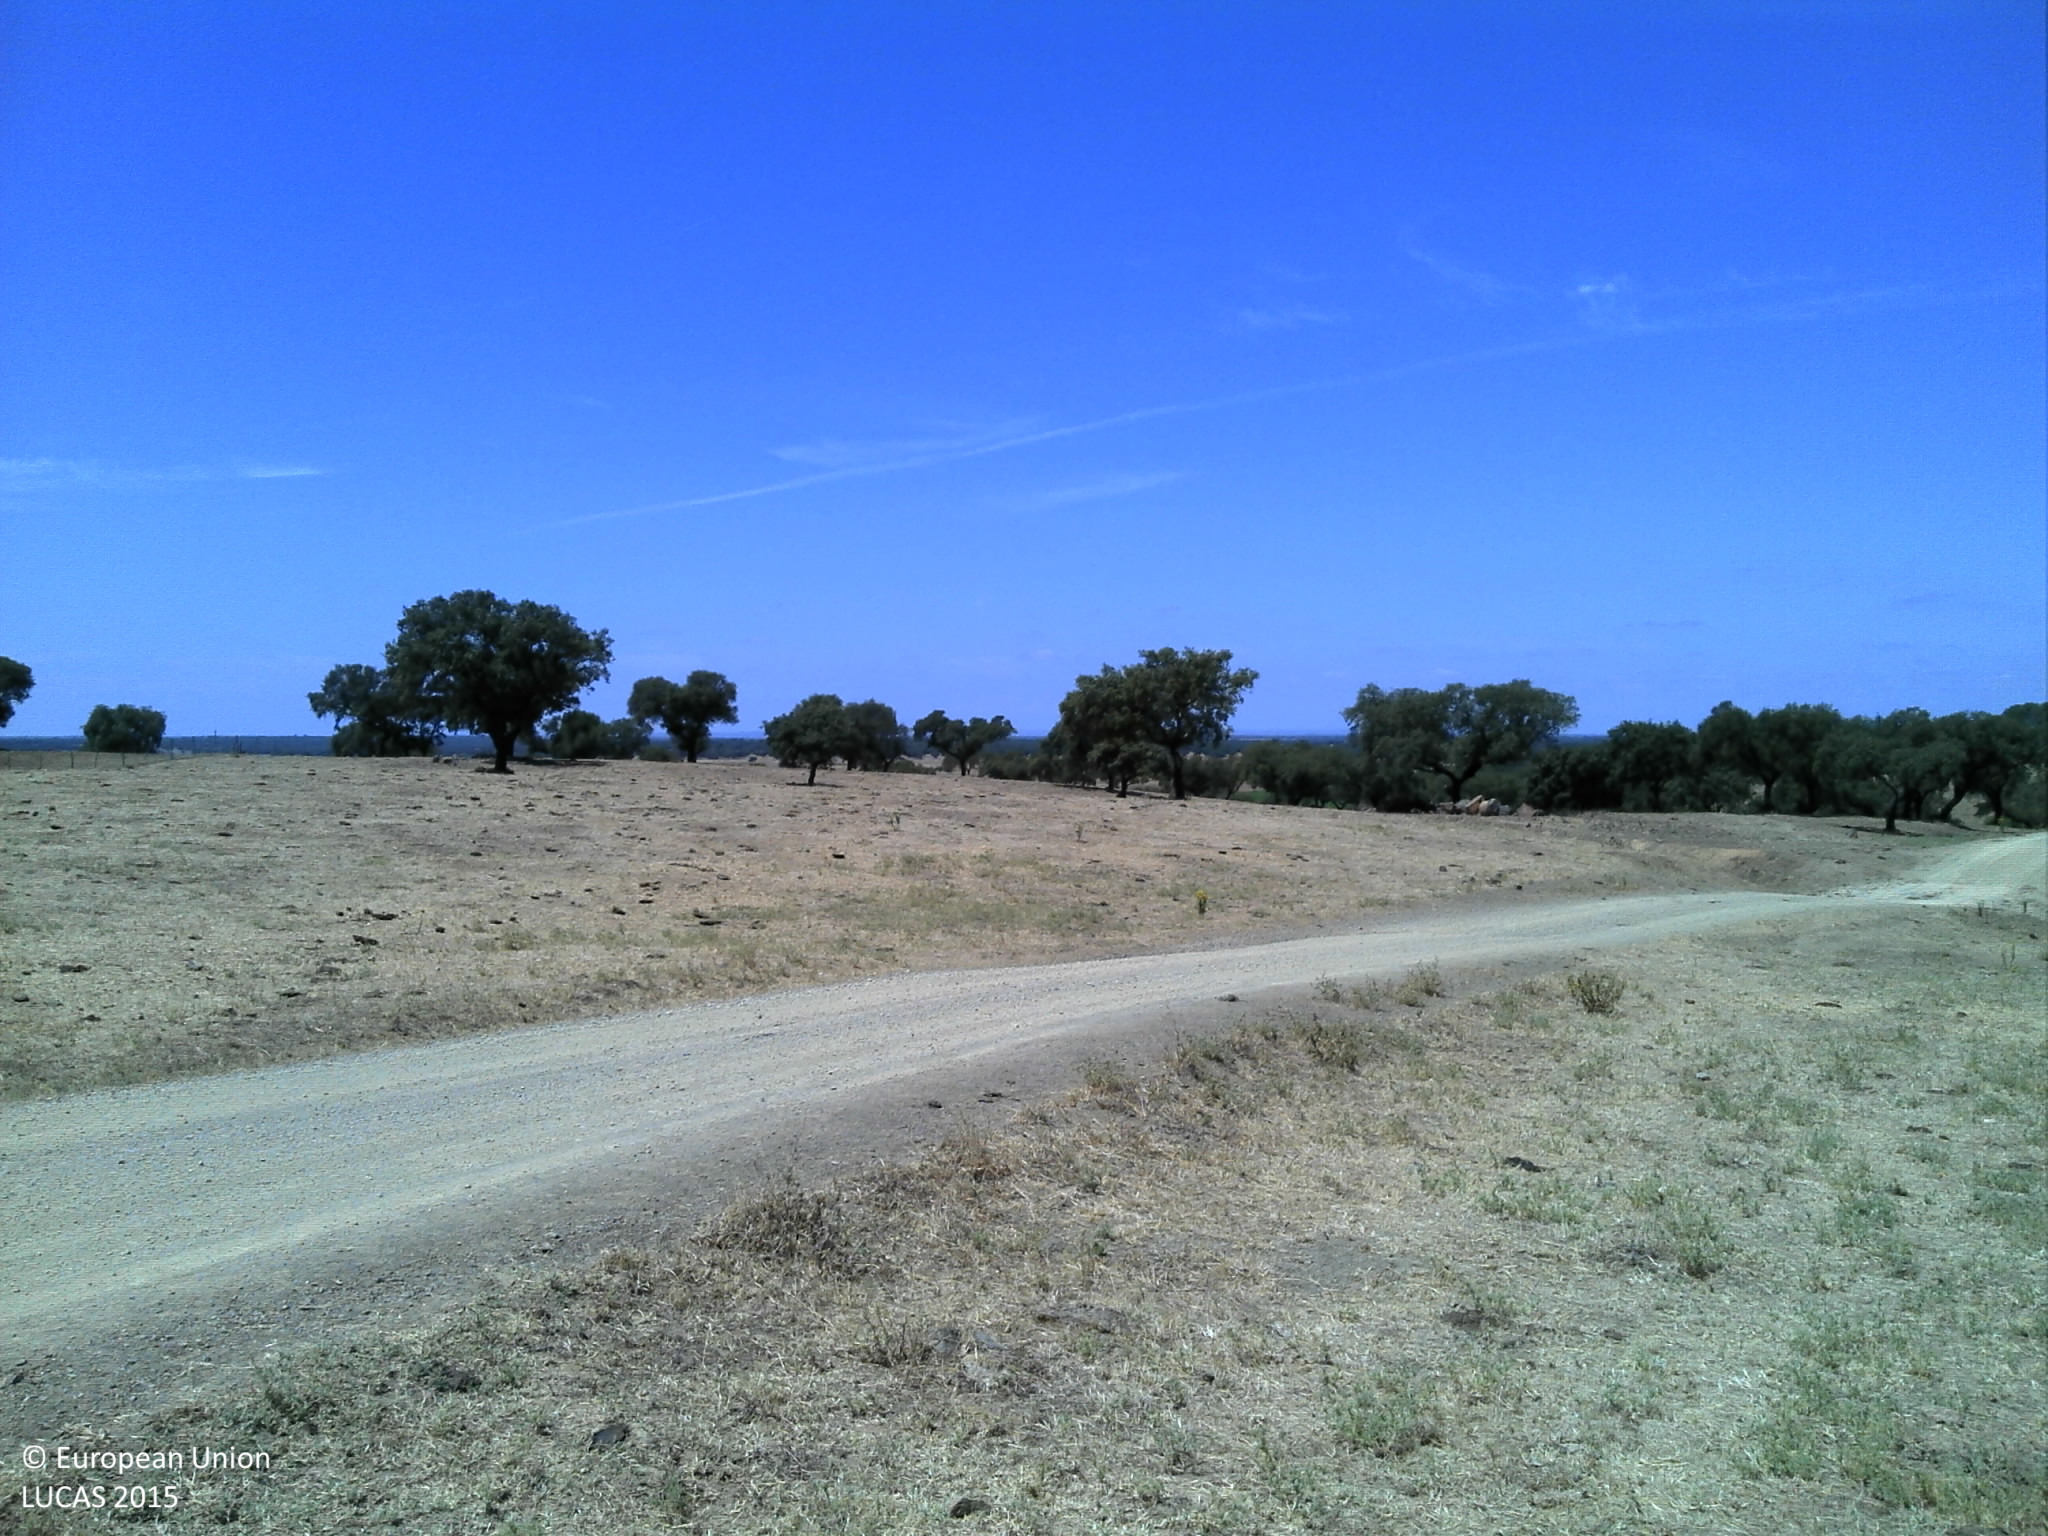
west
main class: Grassland
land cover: Grassland without tree/shrub cover
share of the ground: < 10 %
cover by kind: unconsolidated bare surface 90 %, herbaceous plants 10 %
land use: Agriculture (excluding fallow land and kitchen gardens)
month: June
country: PT
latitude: 38.2659
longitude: -8.1318
